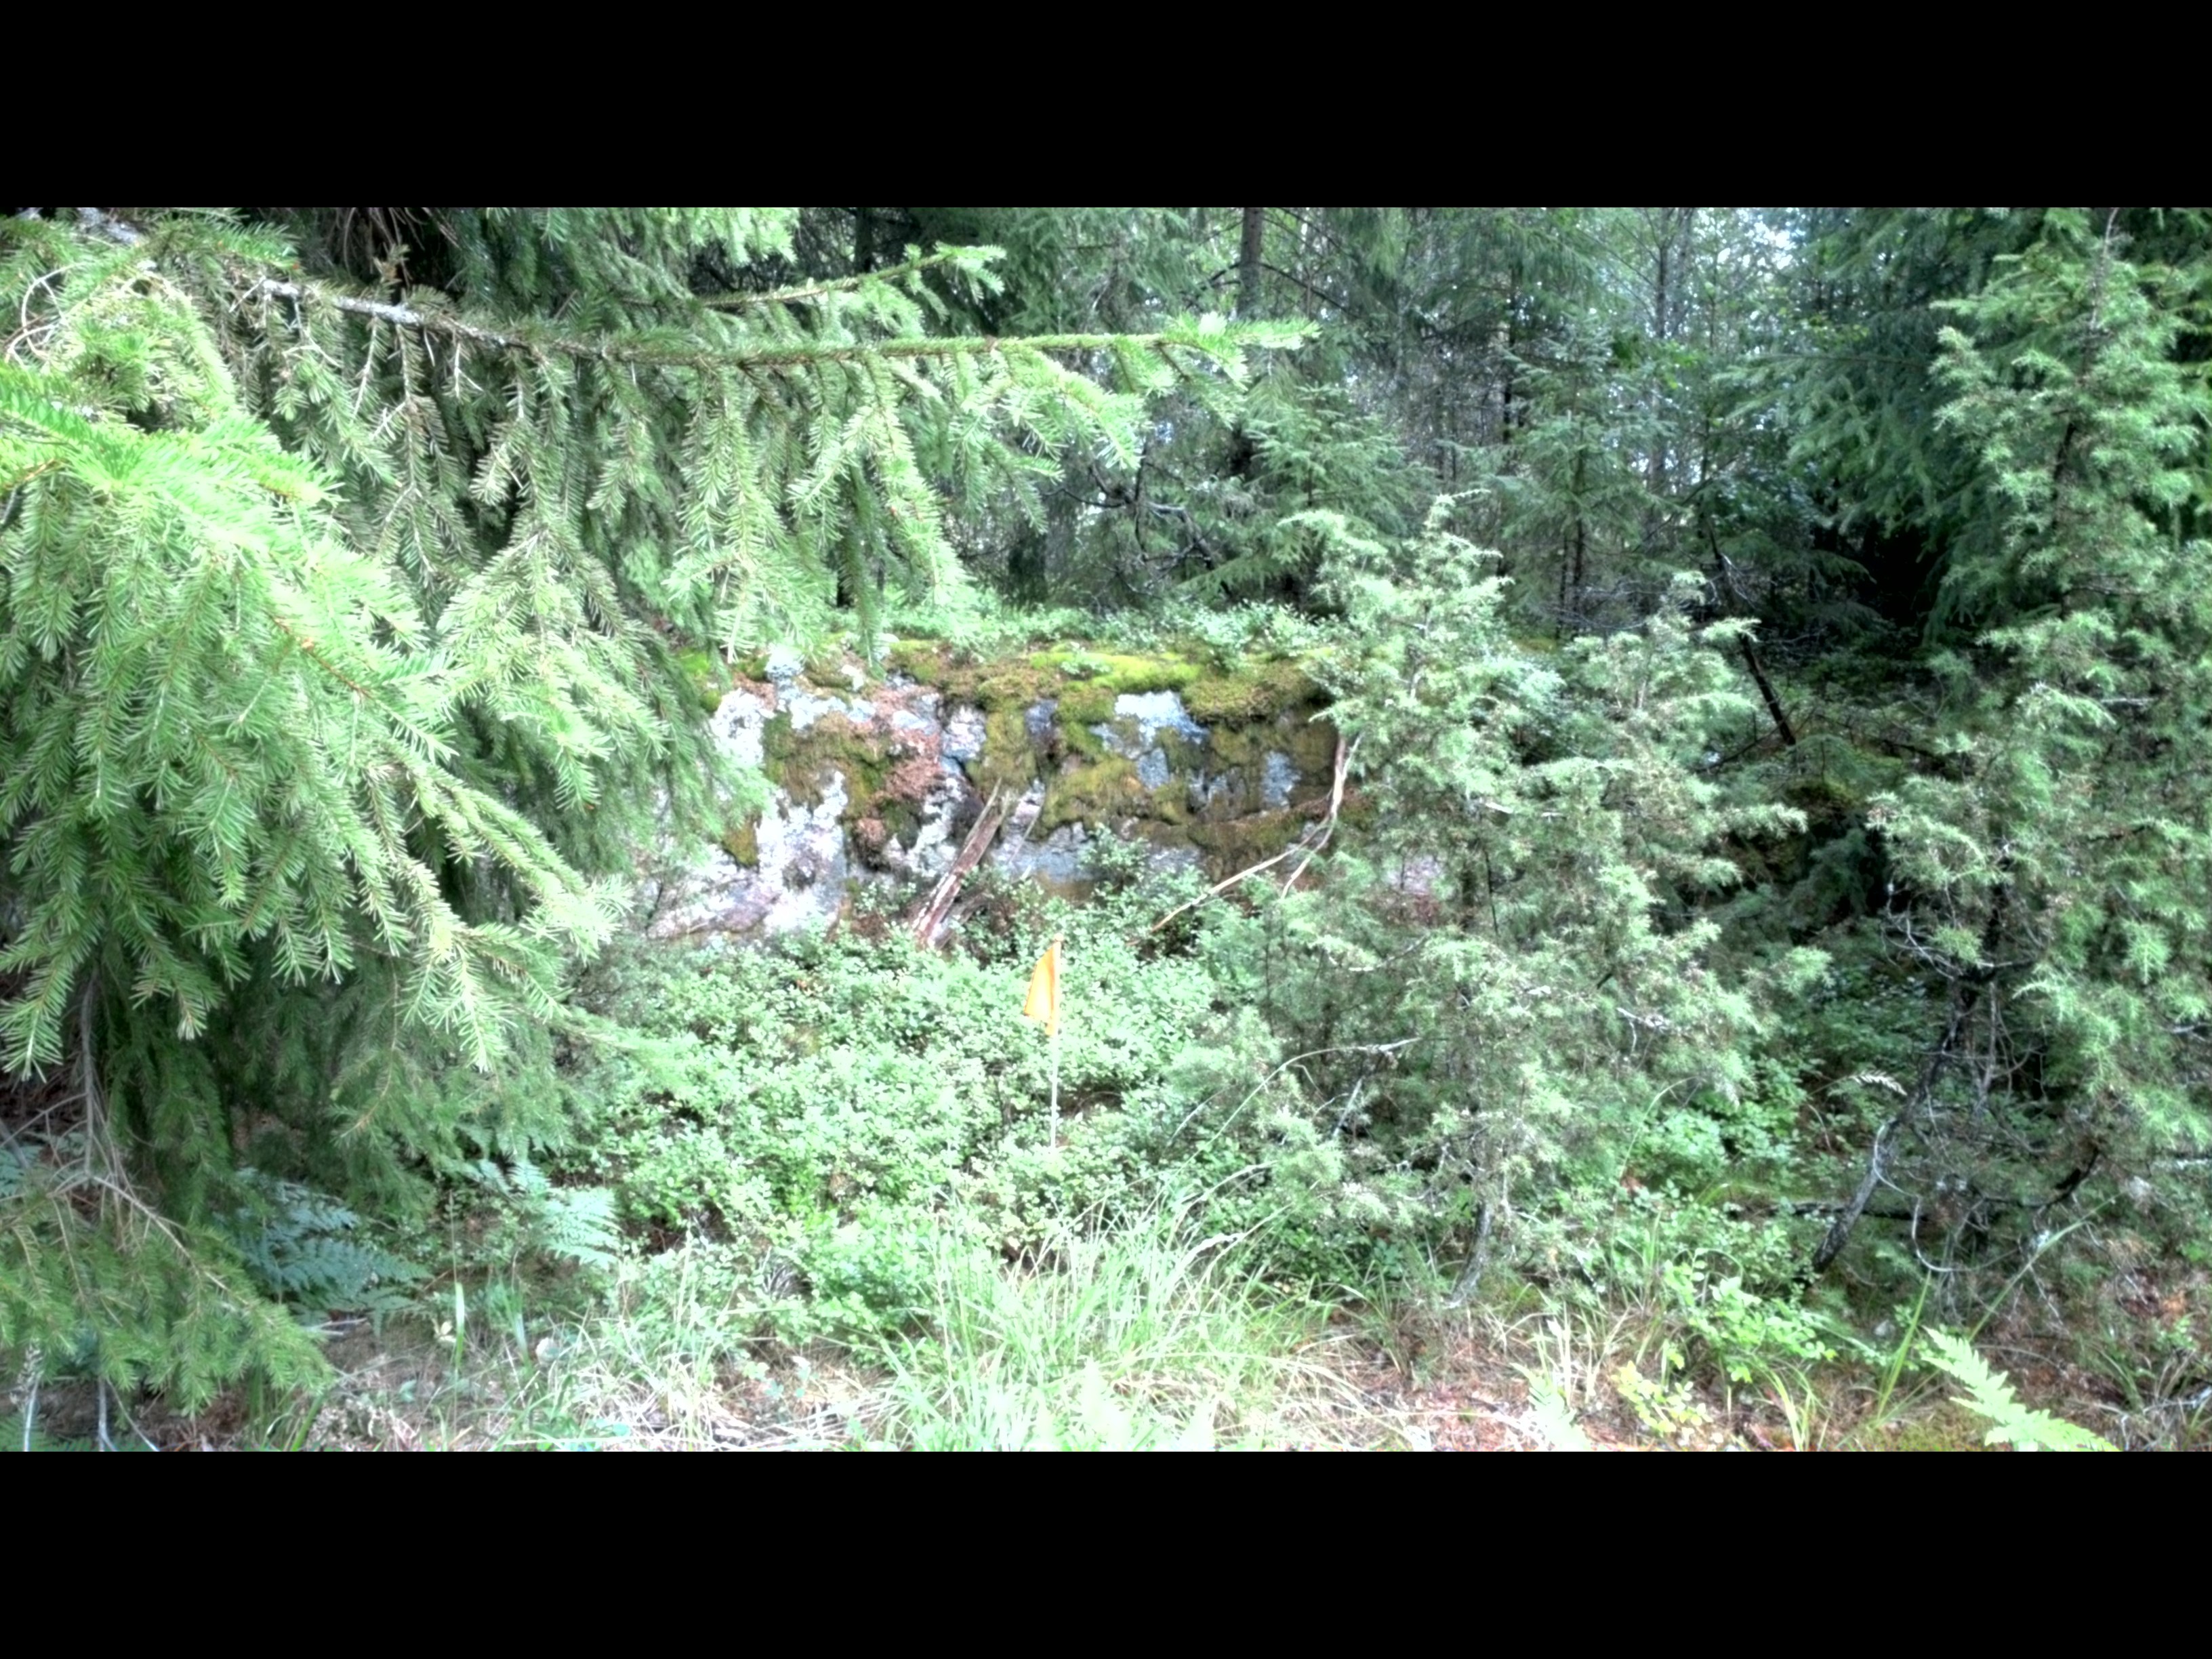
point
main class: Woodland
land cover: Spruce dominated coniferous woodland
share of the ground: 50 - 75 %
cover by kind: coniferous forest trees 55 %, shrubs 20 %, broadleaved forest trees 10 %, herbaceous plants 10 %, lichens and mosses 5 %
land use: Forestry
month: July
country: SE
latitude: 58.3815
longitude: 16.2379
